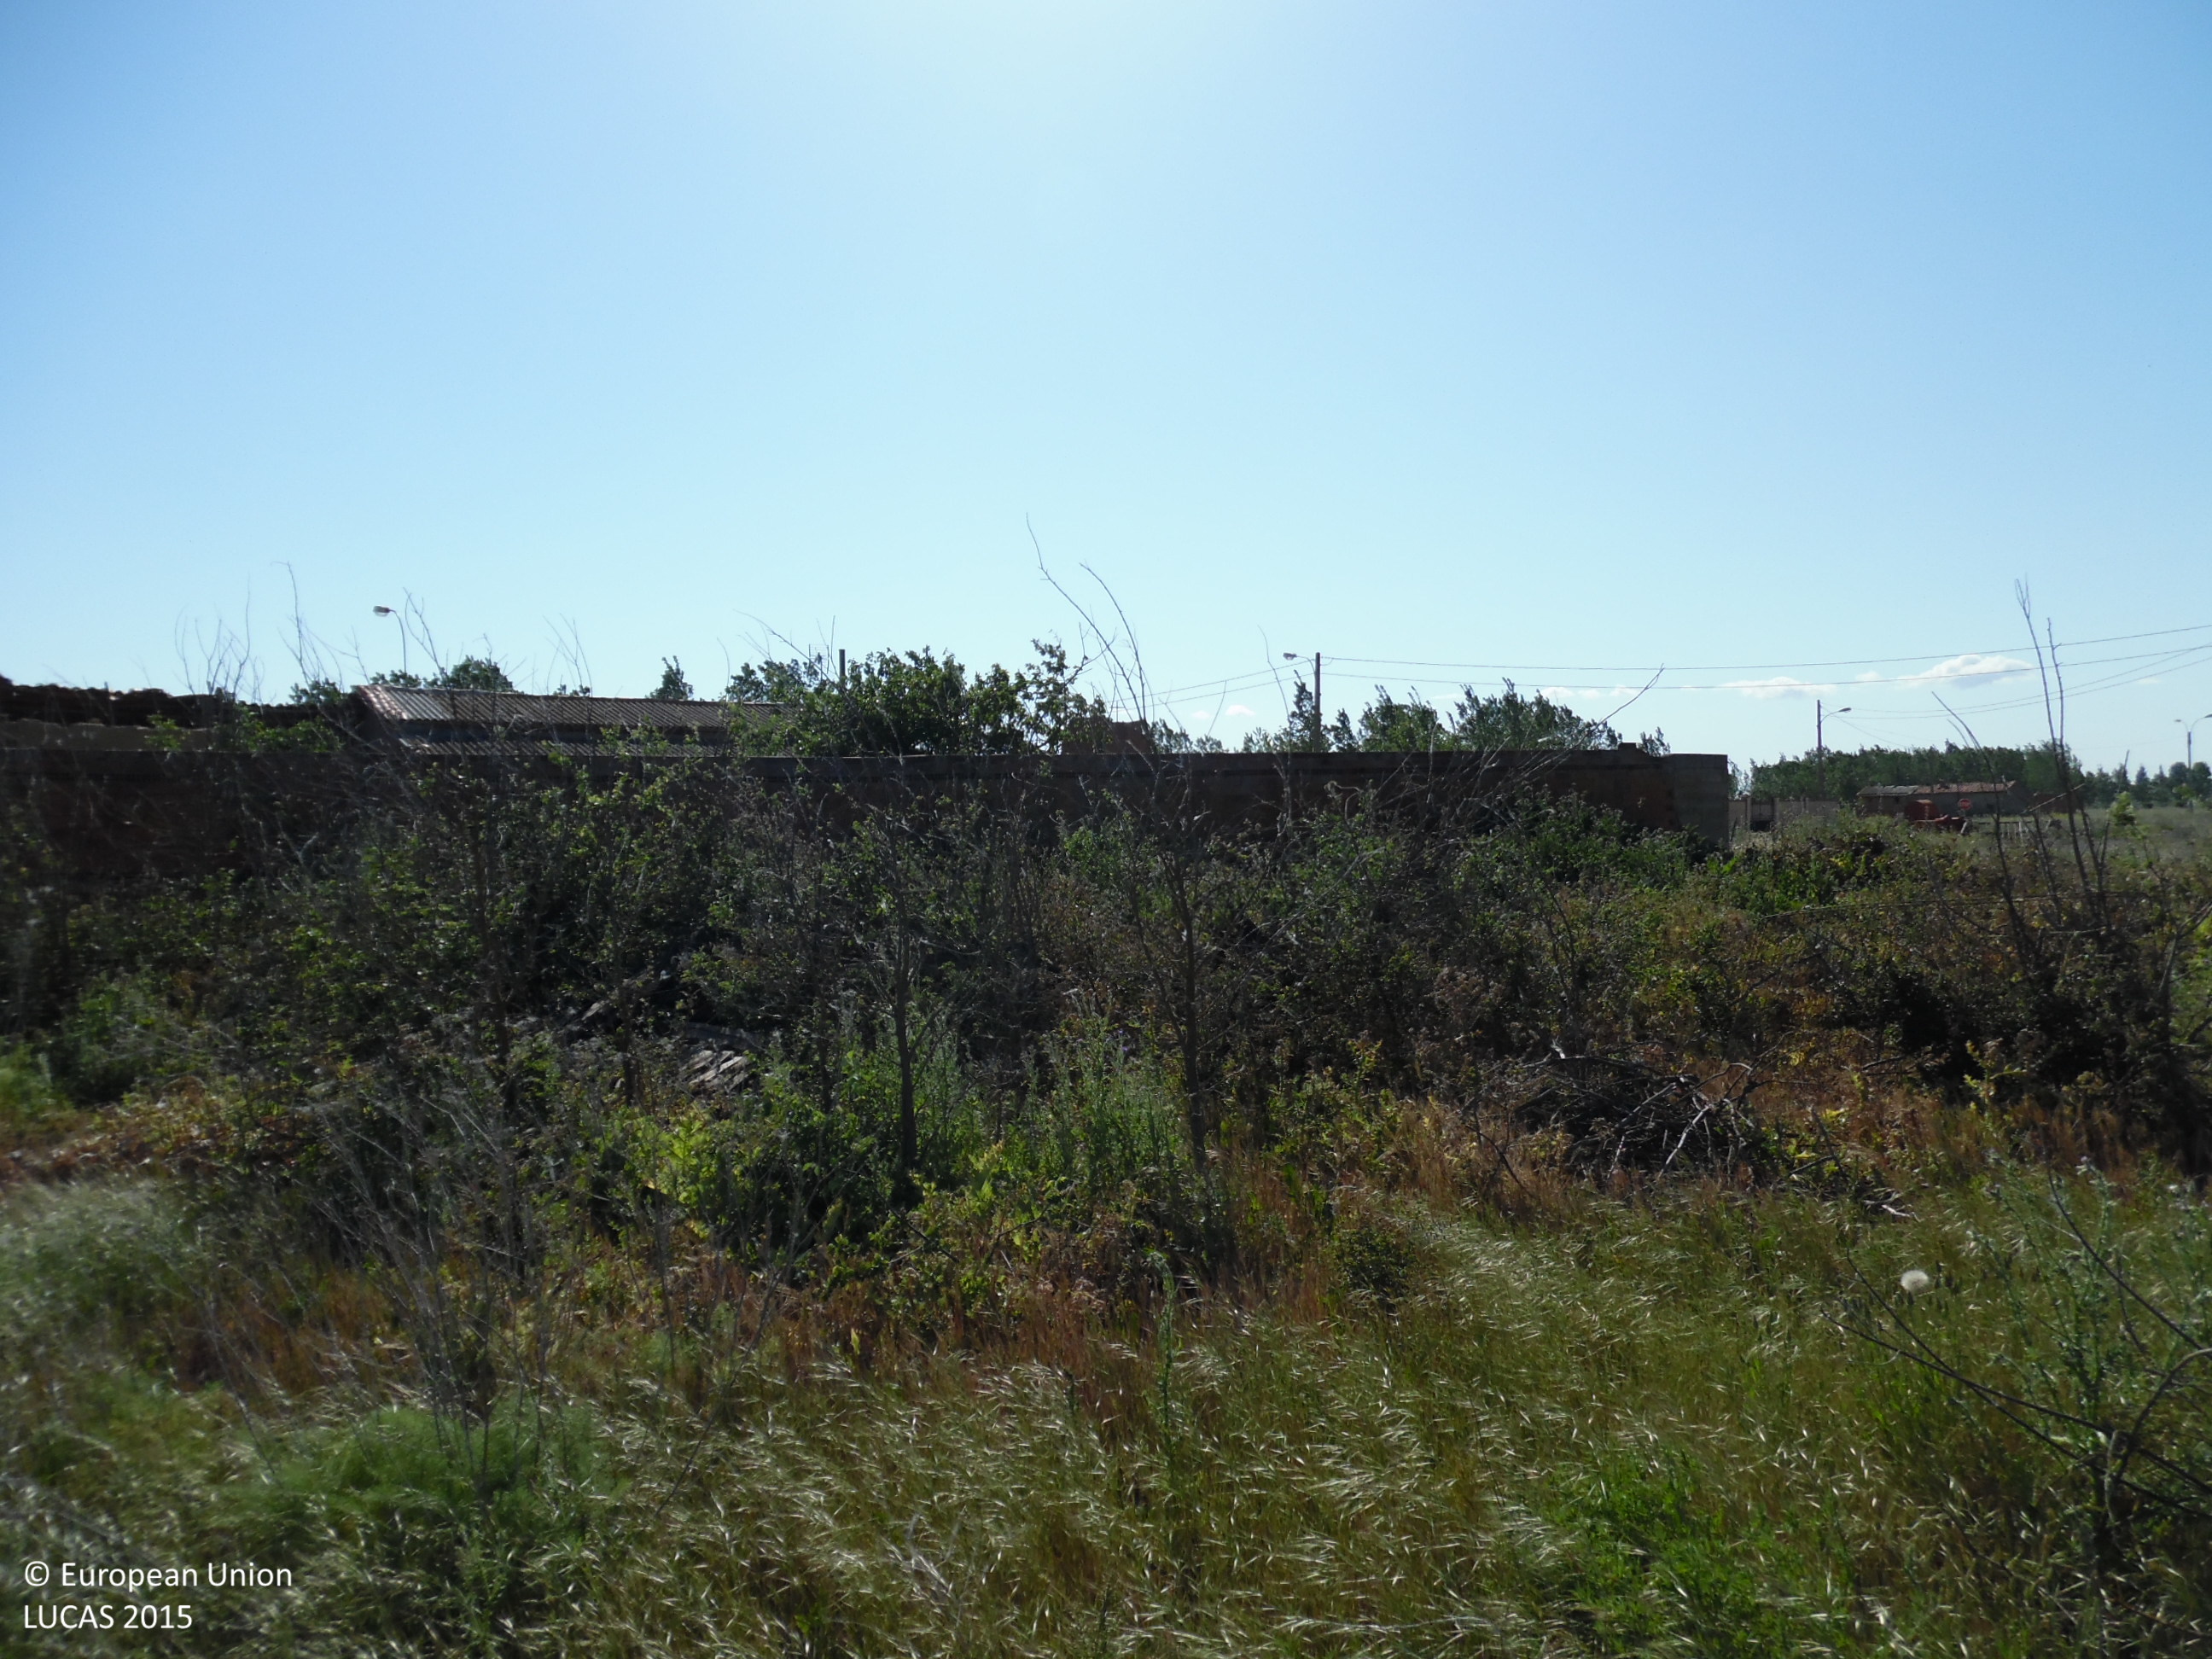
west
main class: Grassland
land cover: Grassland without tree/shrub cover
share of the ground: > 75 %
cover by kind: herbaceous plants 95 %, shrubs 5 %
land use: Abandoned areas
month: May
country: ES
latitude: 42.2443
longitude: -5.7175
